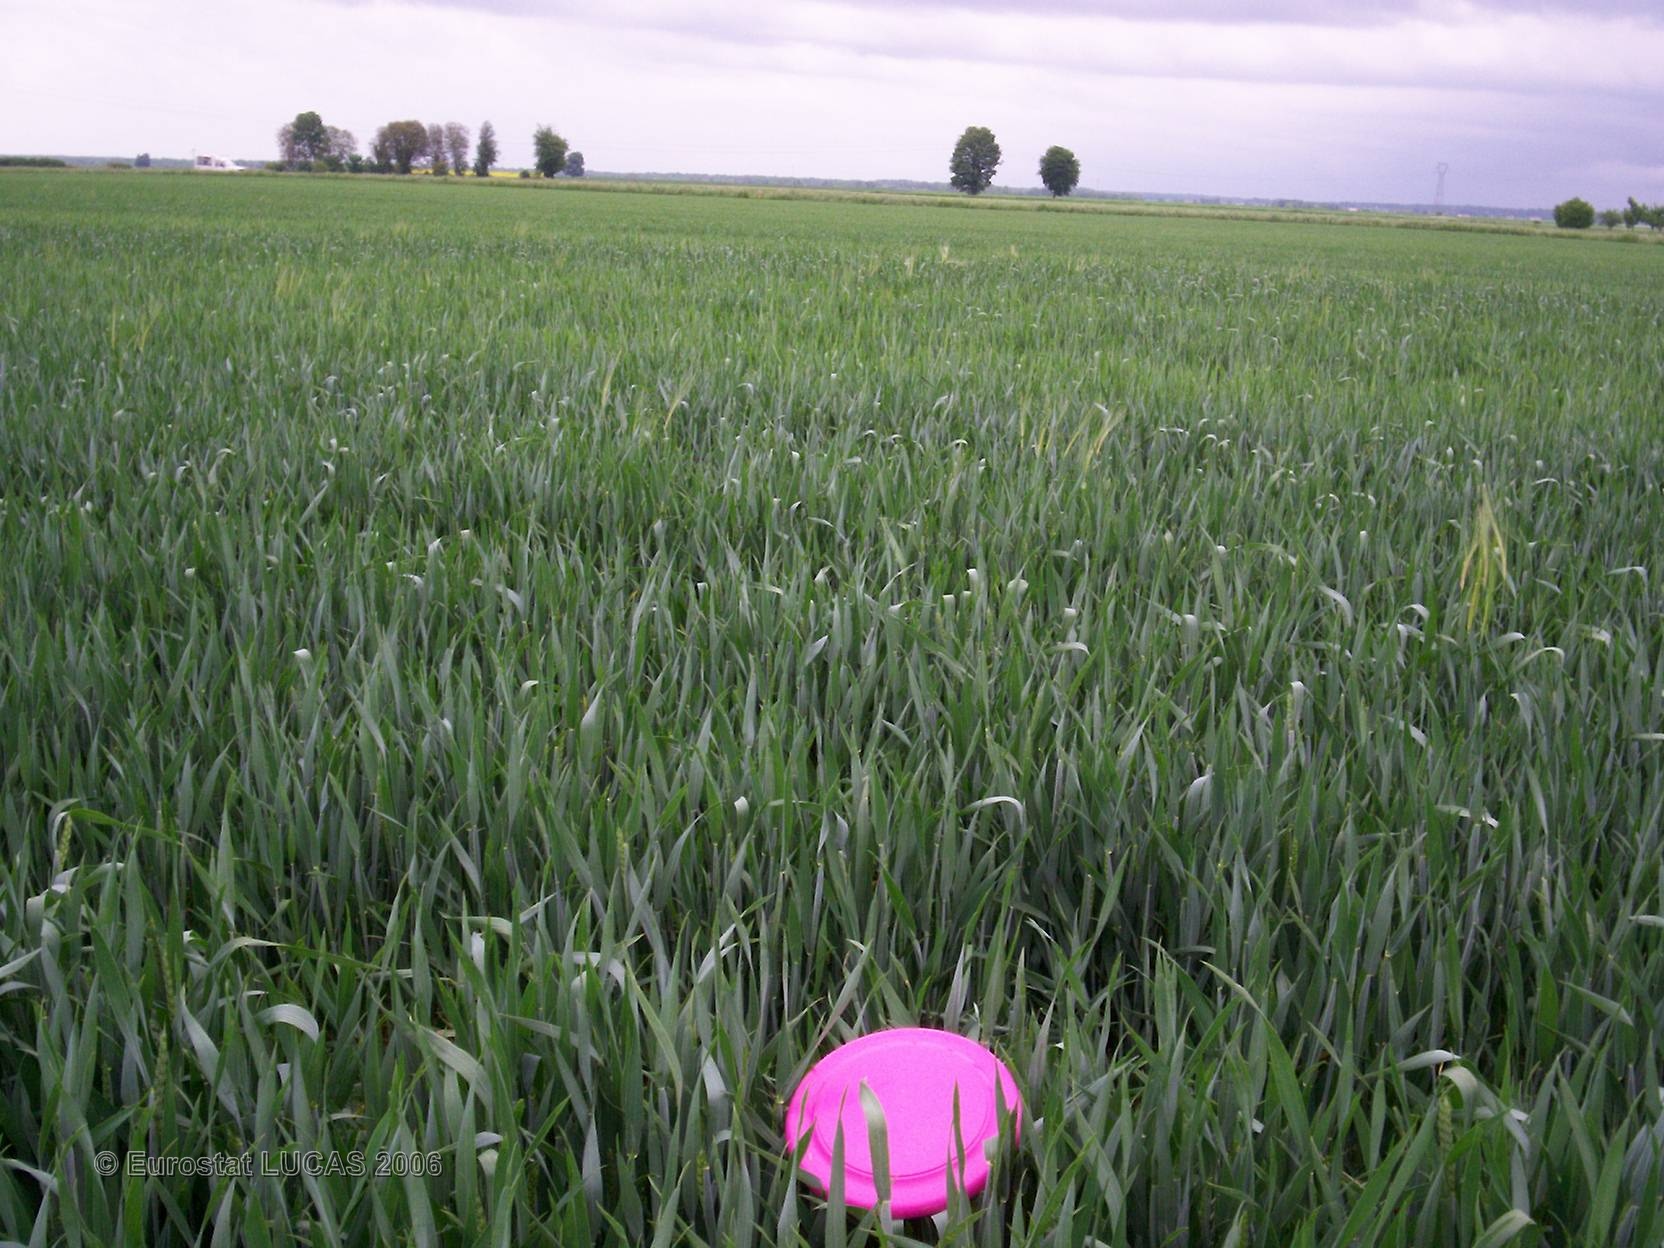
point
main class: Cropland
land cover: Common wheat
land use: Agriculture (excluding fallow land and kitchen gardens)
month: May
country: FR
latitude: 48.3584
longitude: 4.5316
